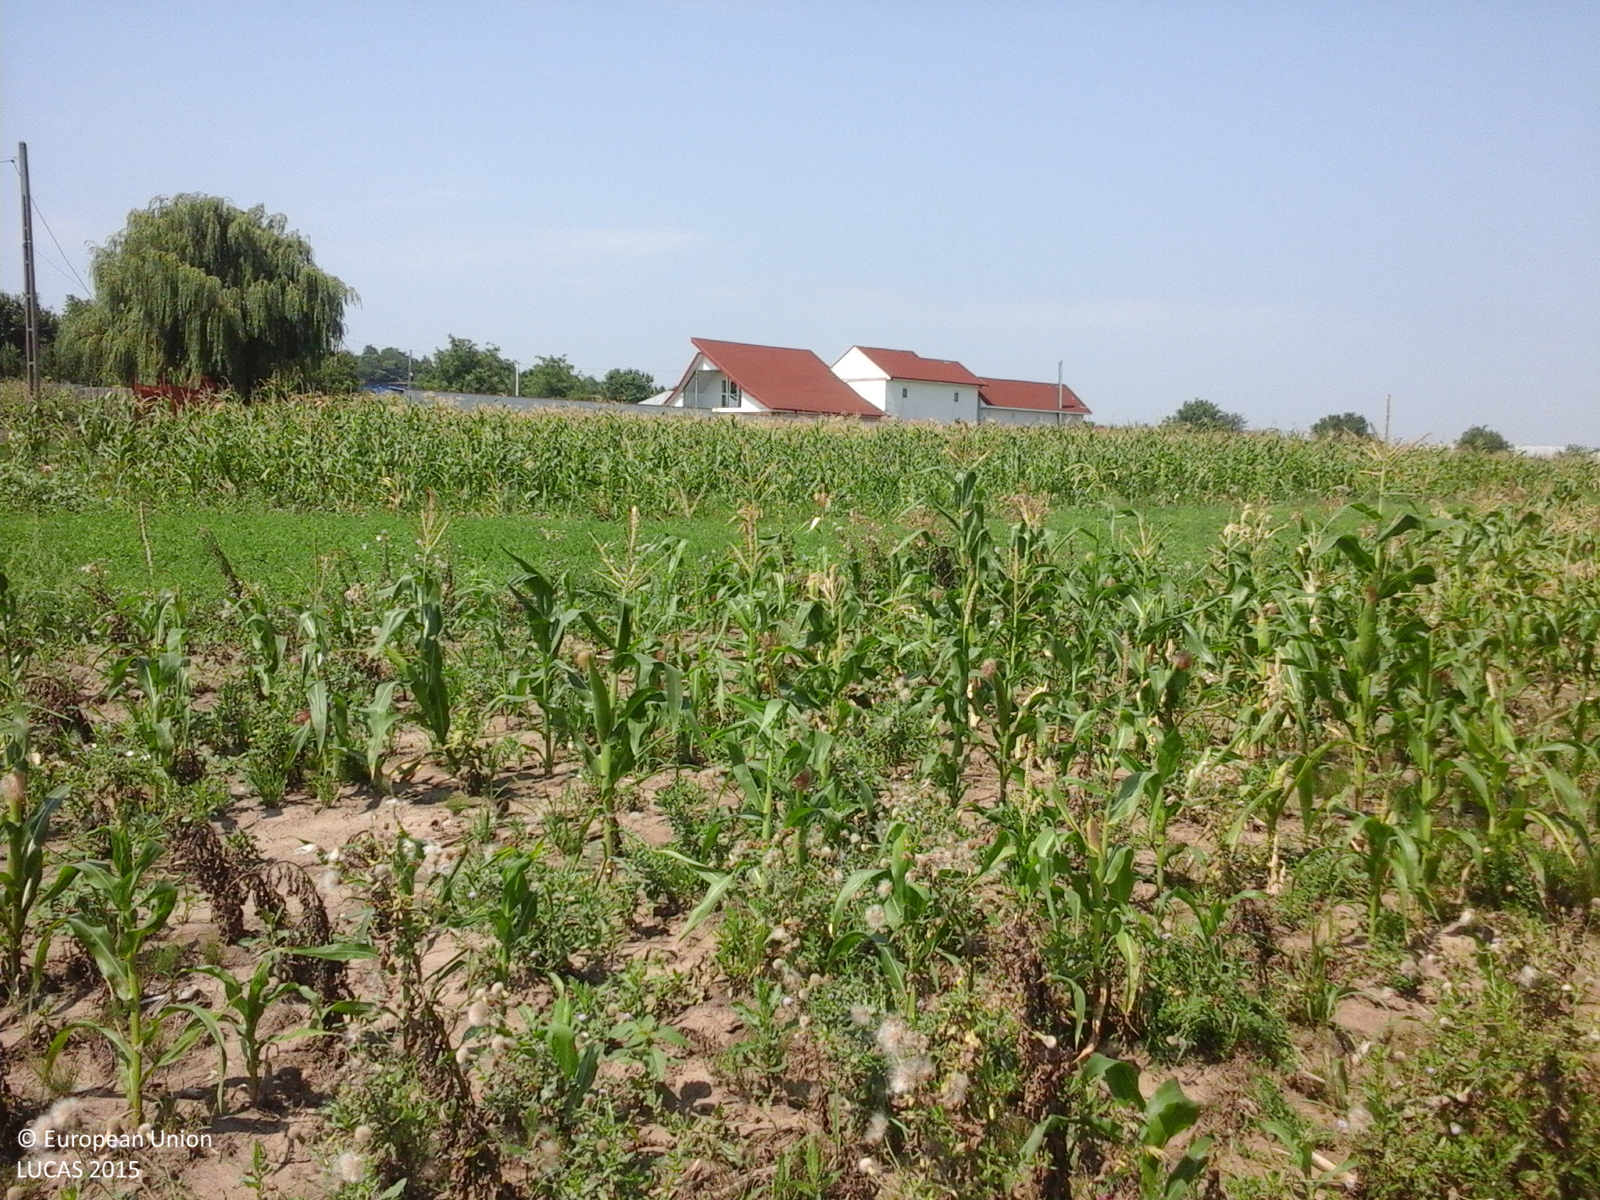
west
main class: Cropland
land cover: Maize
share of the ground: > 75 %
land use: Agriculture (excluding fallow land and kitchen gardens)
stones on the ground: < 10 %
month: August
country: RO
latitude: 46.2135
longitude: 27.0900
